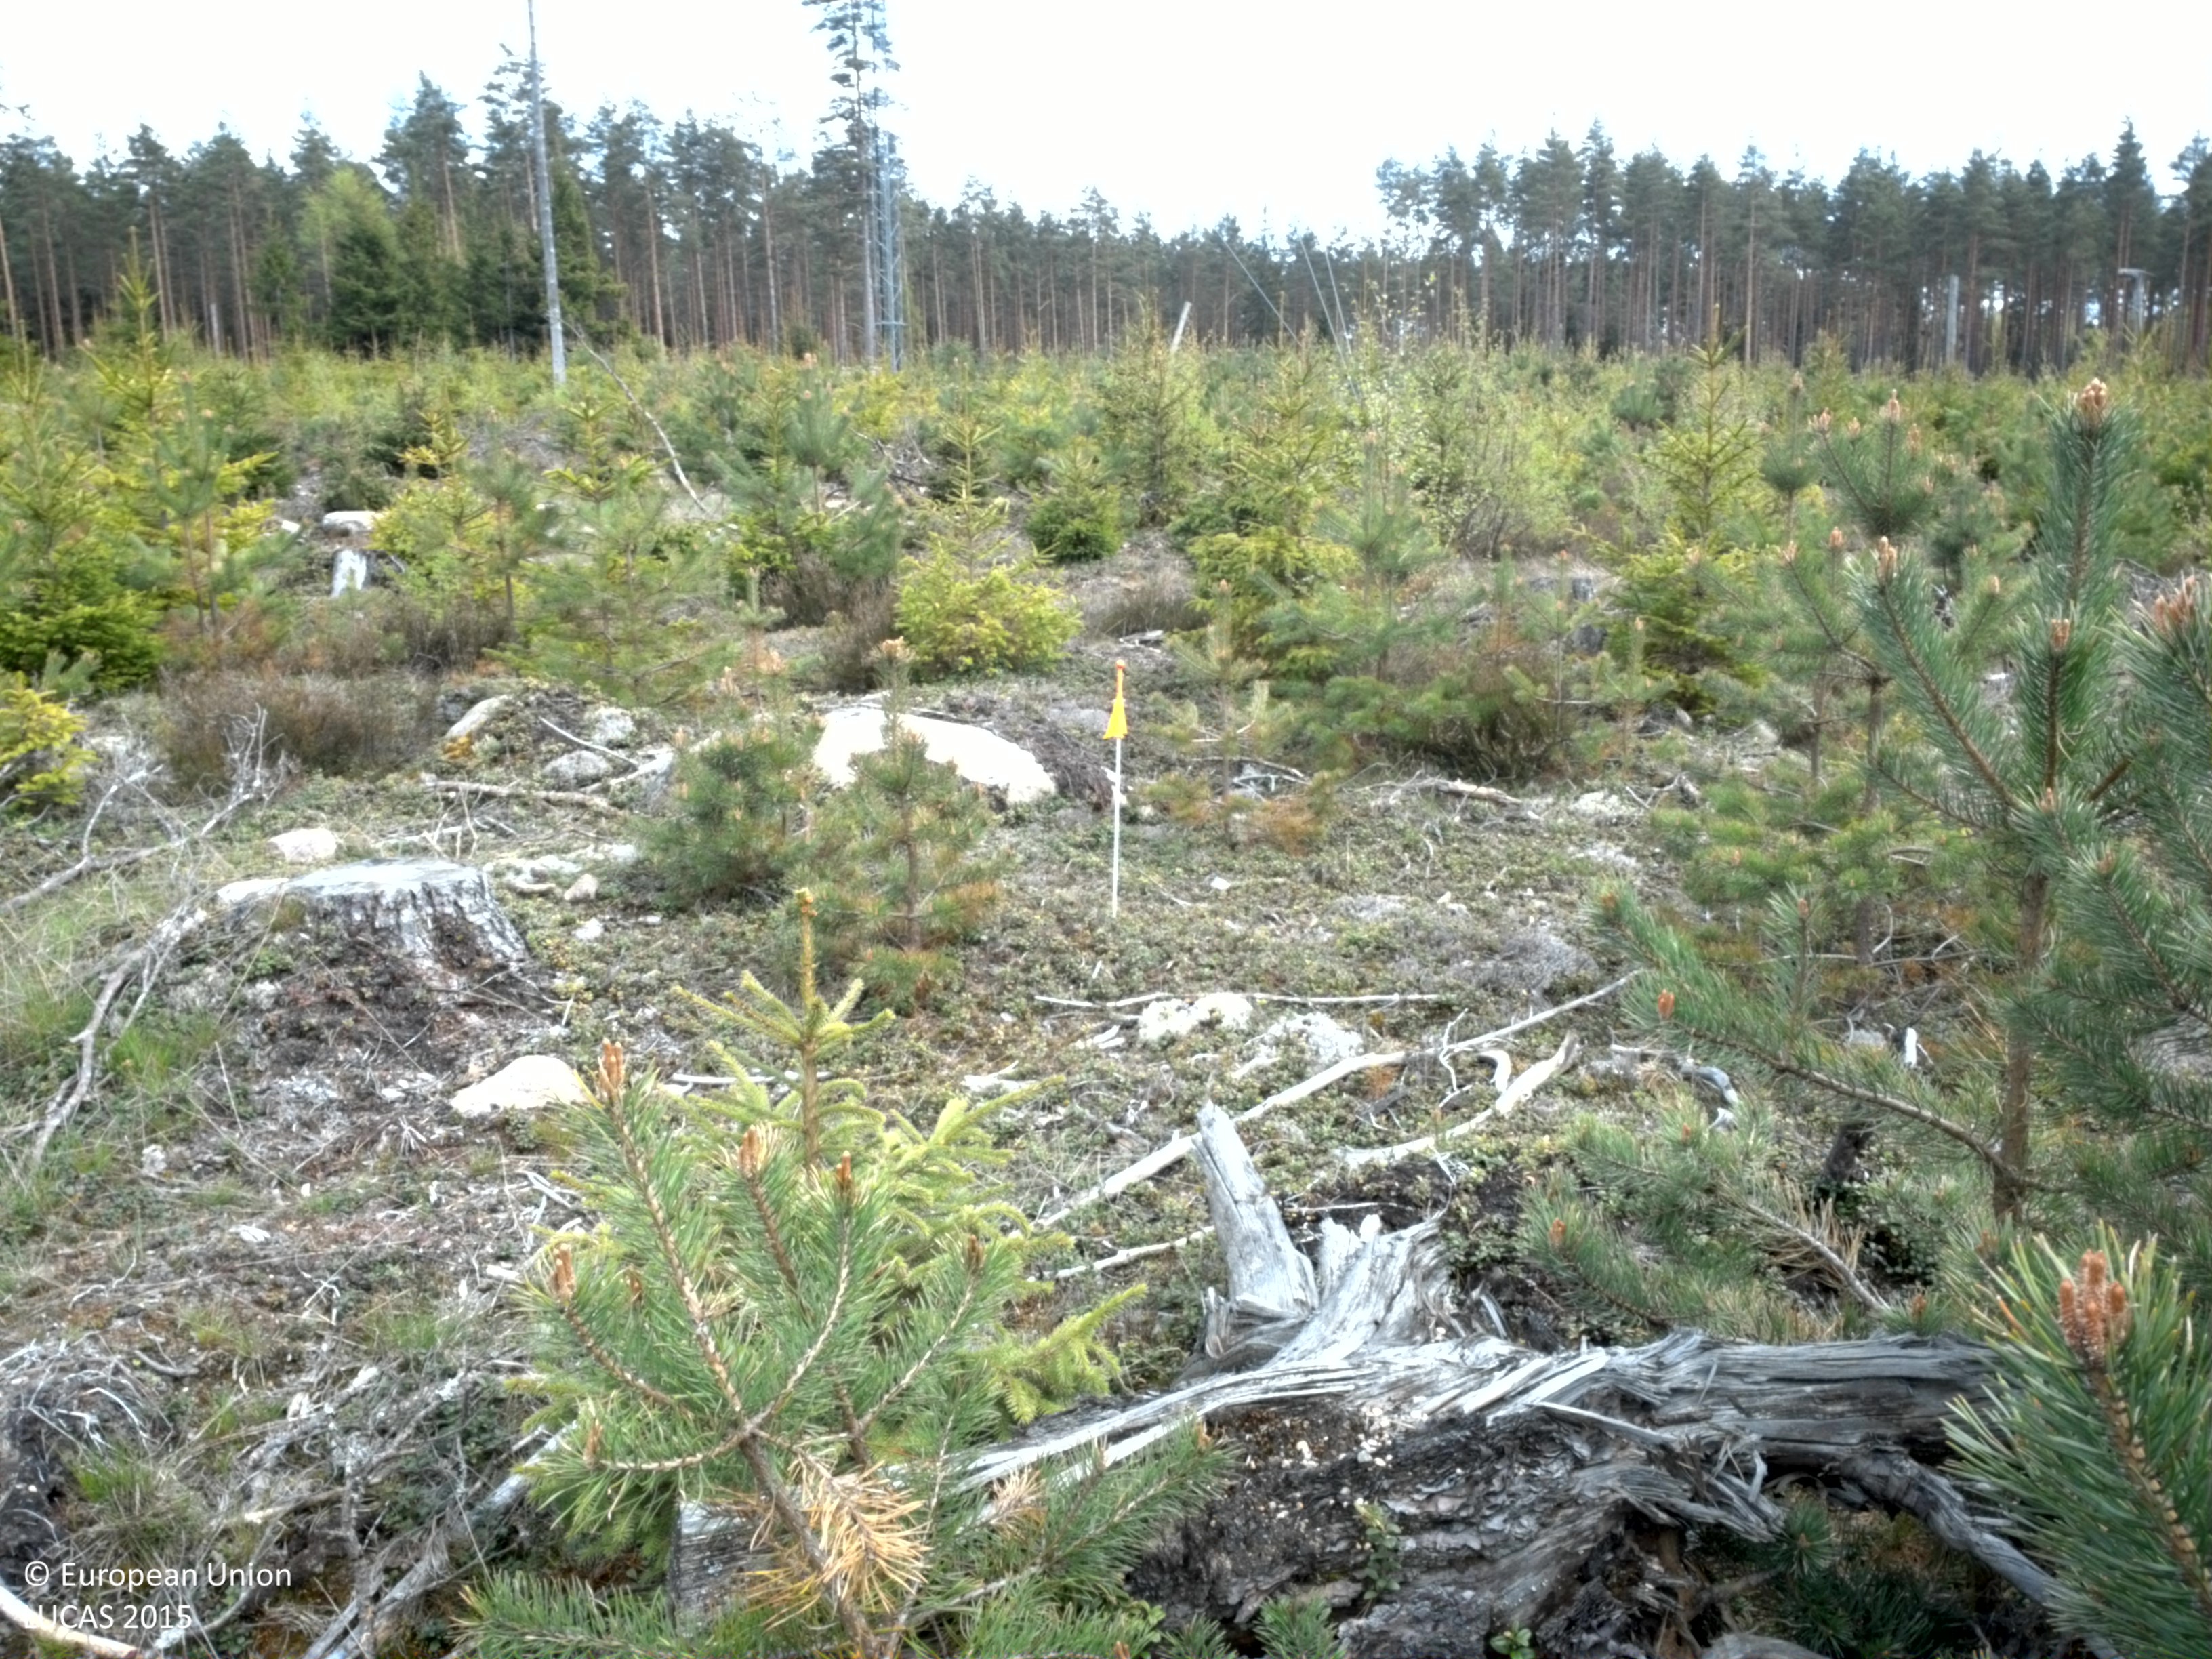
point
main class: Woodland
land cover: Other coniferous woodland
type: boreal forest
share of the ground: > 75 %
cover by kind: coniferous forest trees 90 %, shrubs 5 %, lichens and mosses 5 %
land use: Forestry
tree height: < 5 m
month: May
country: SE
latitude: 56.7764
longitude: 15.4150
